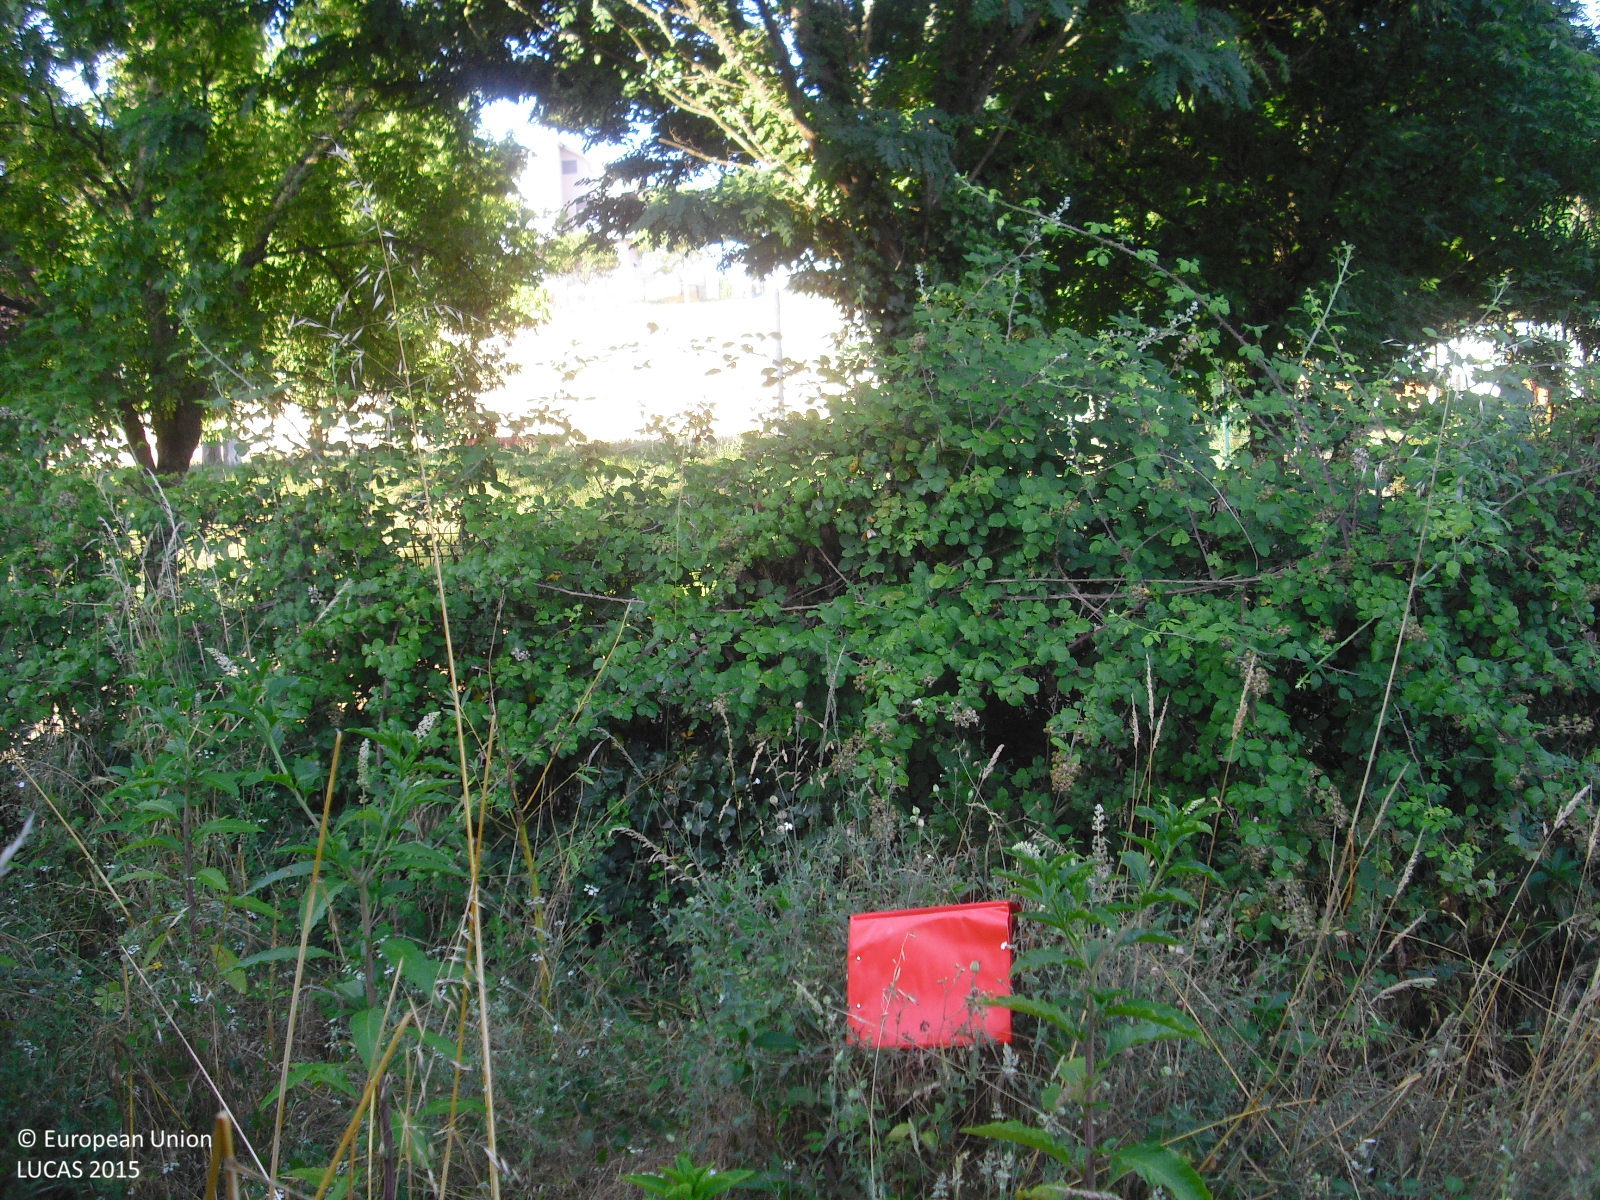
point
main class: Shrubland
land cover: Shrubland with sparse tree cover
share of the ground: 25 - 50 %
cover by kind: herbaceous plants 65 %, shrubs 30 %, broadleaved forest trees 5 %
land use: Abandoned areas
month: June
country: ES
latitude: 42.3647
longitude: -7.8411
